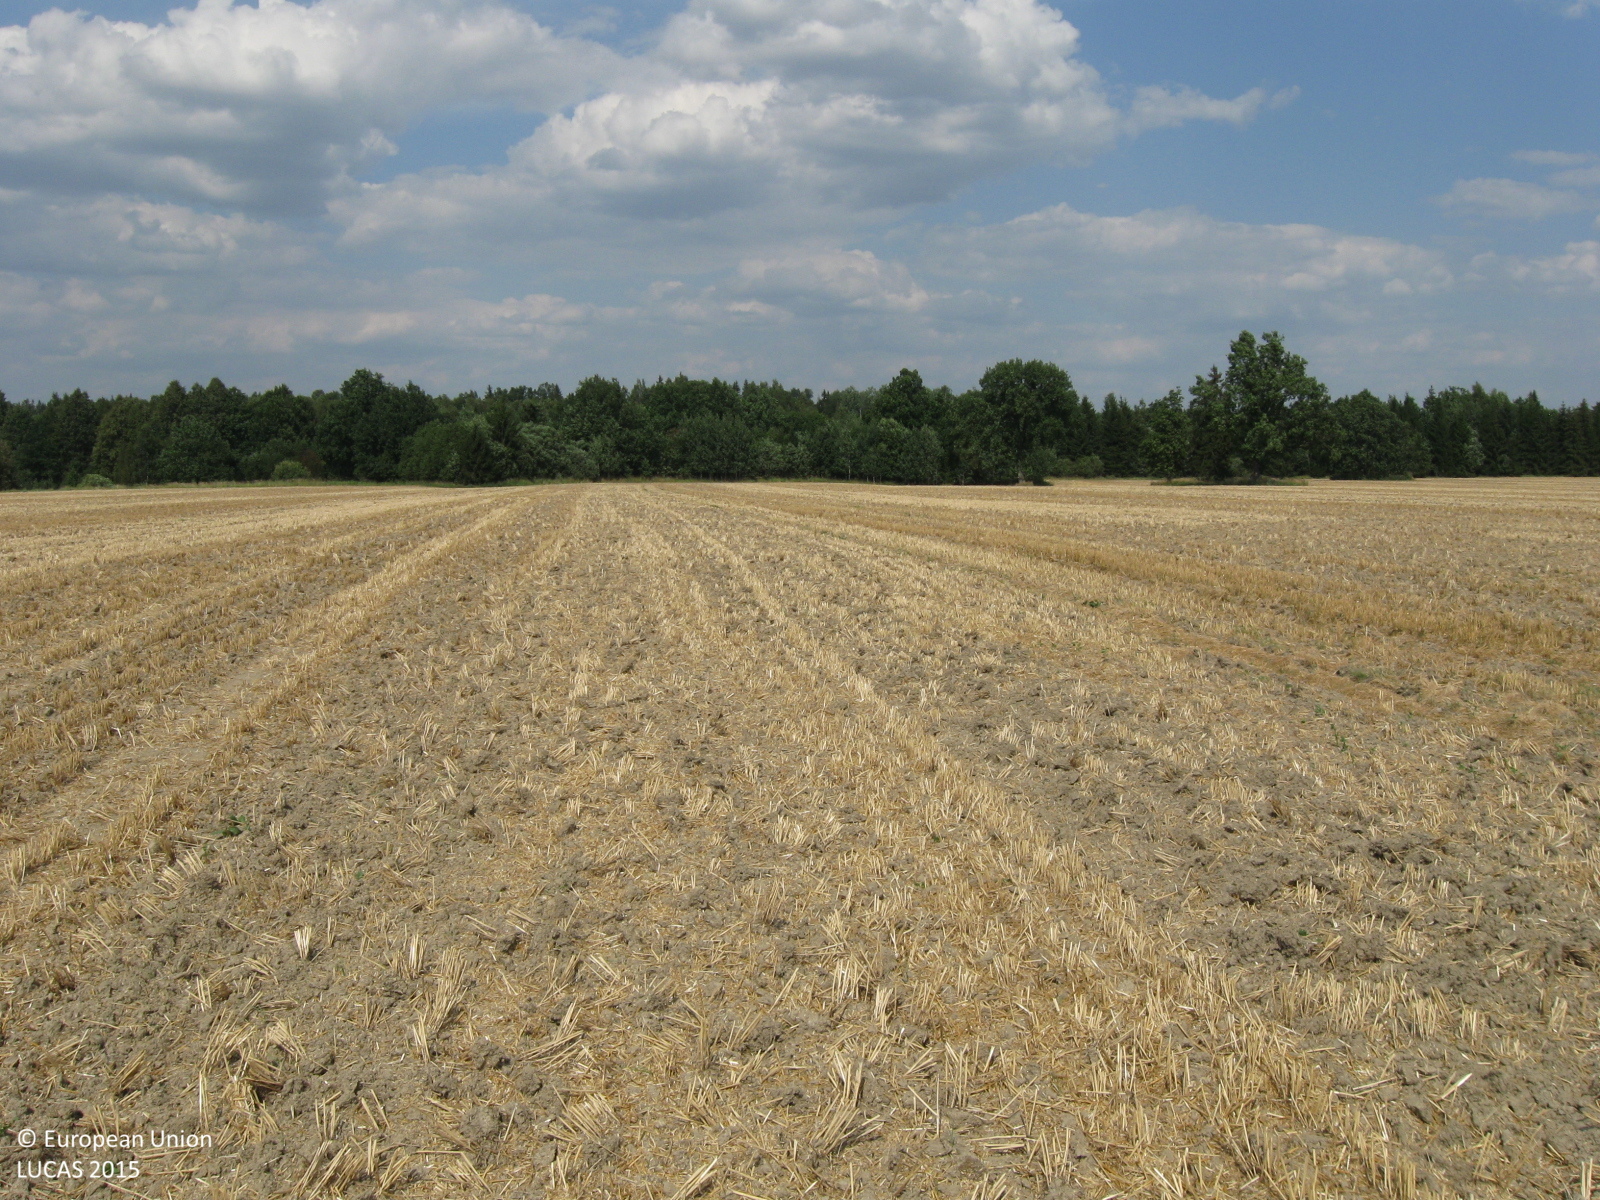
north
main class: Cropland
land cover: Common wheat
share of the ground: < 10 %
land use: Agriculture (excluding fallow land and kitchen gardens)
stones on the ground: < 10 %
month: August
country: LT
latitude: 55.5169
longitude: 22.8800
